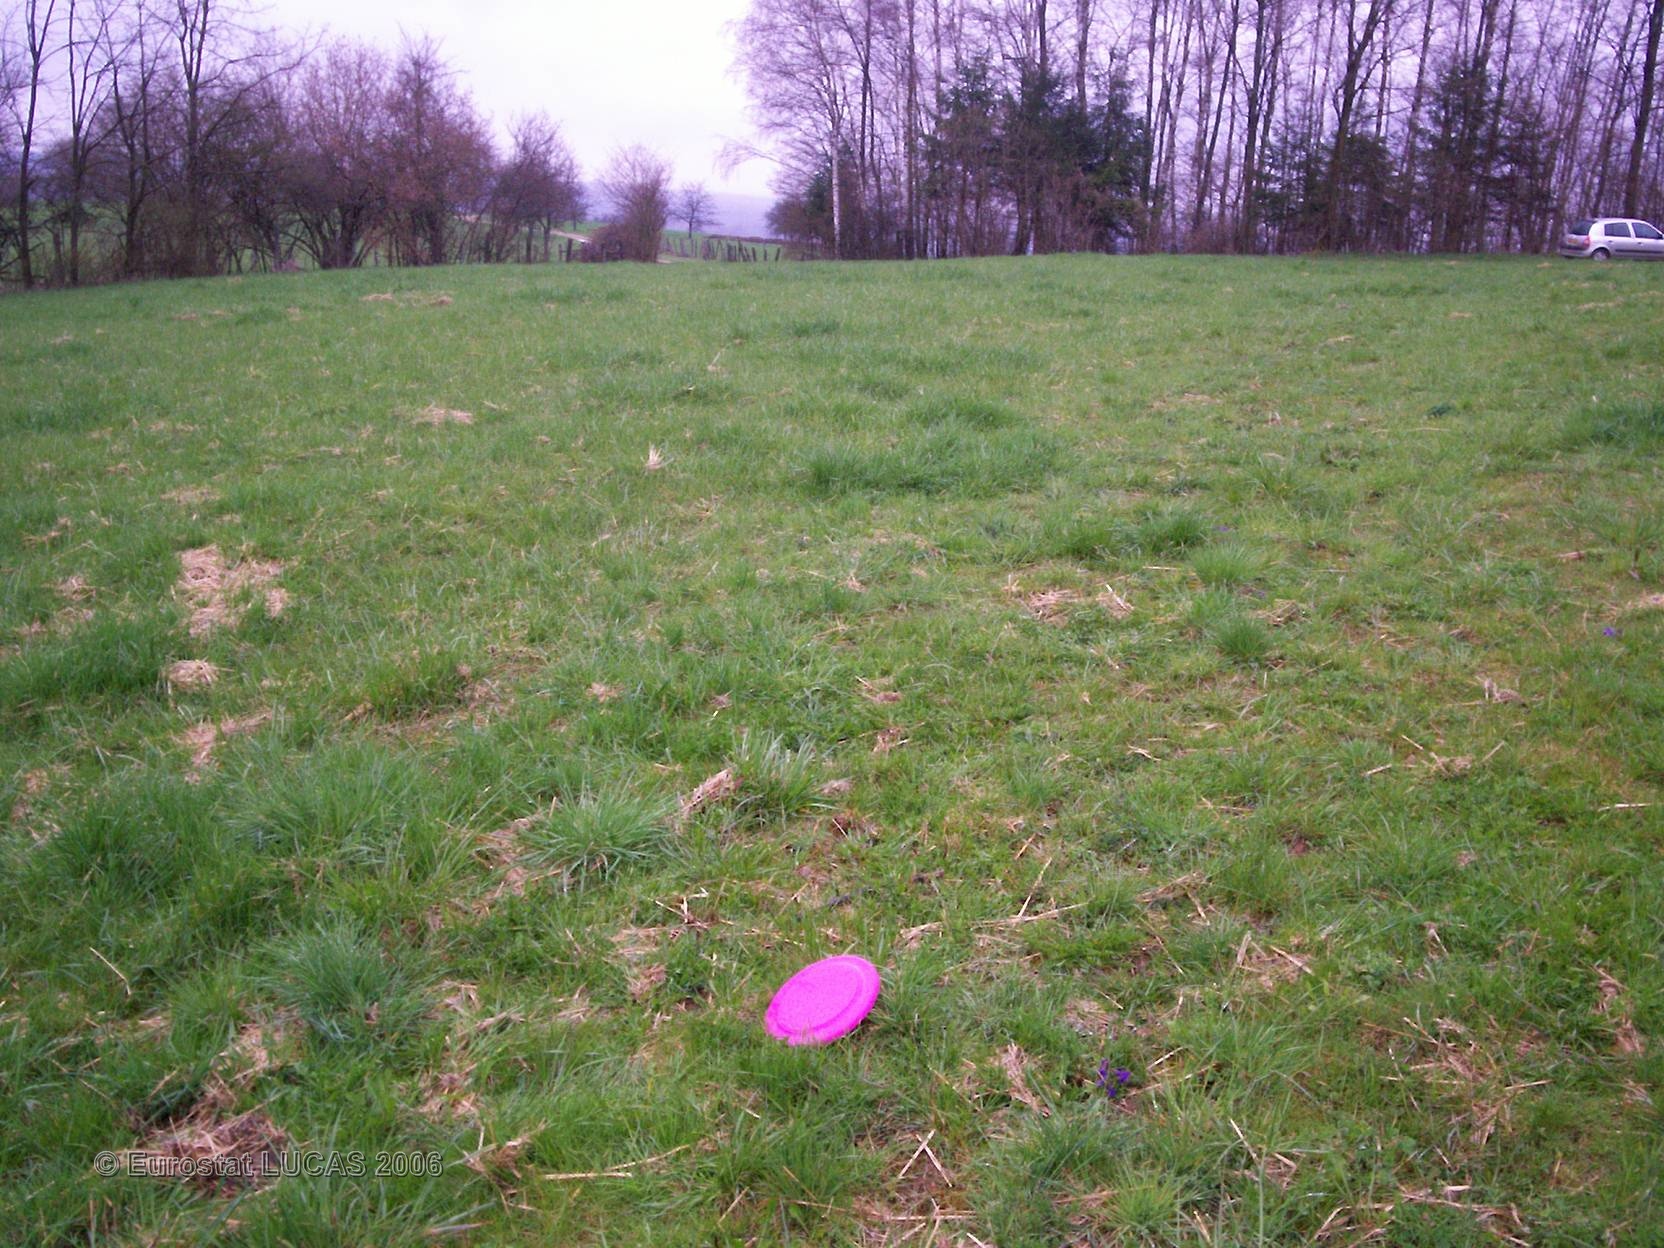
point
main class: Grassland
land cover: Grassland without tree/shrub cover
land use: Agriculture (excluding fallow land and kitchen gardens)
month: April
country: FR
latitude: 47.7824
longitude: 6.2774
